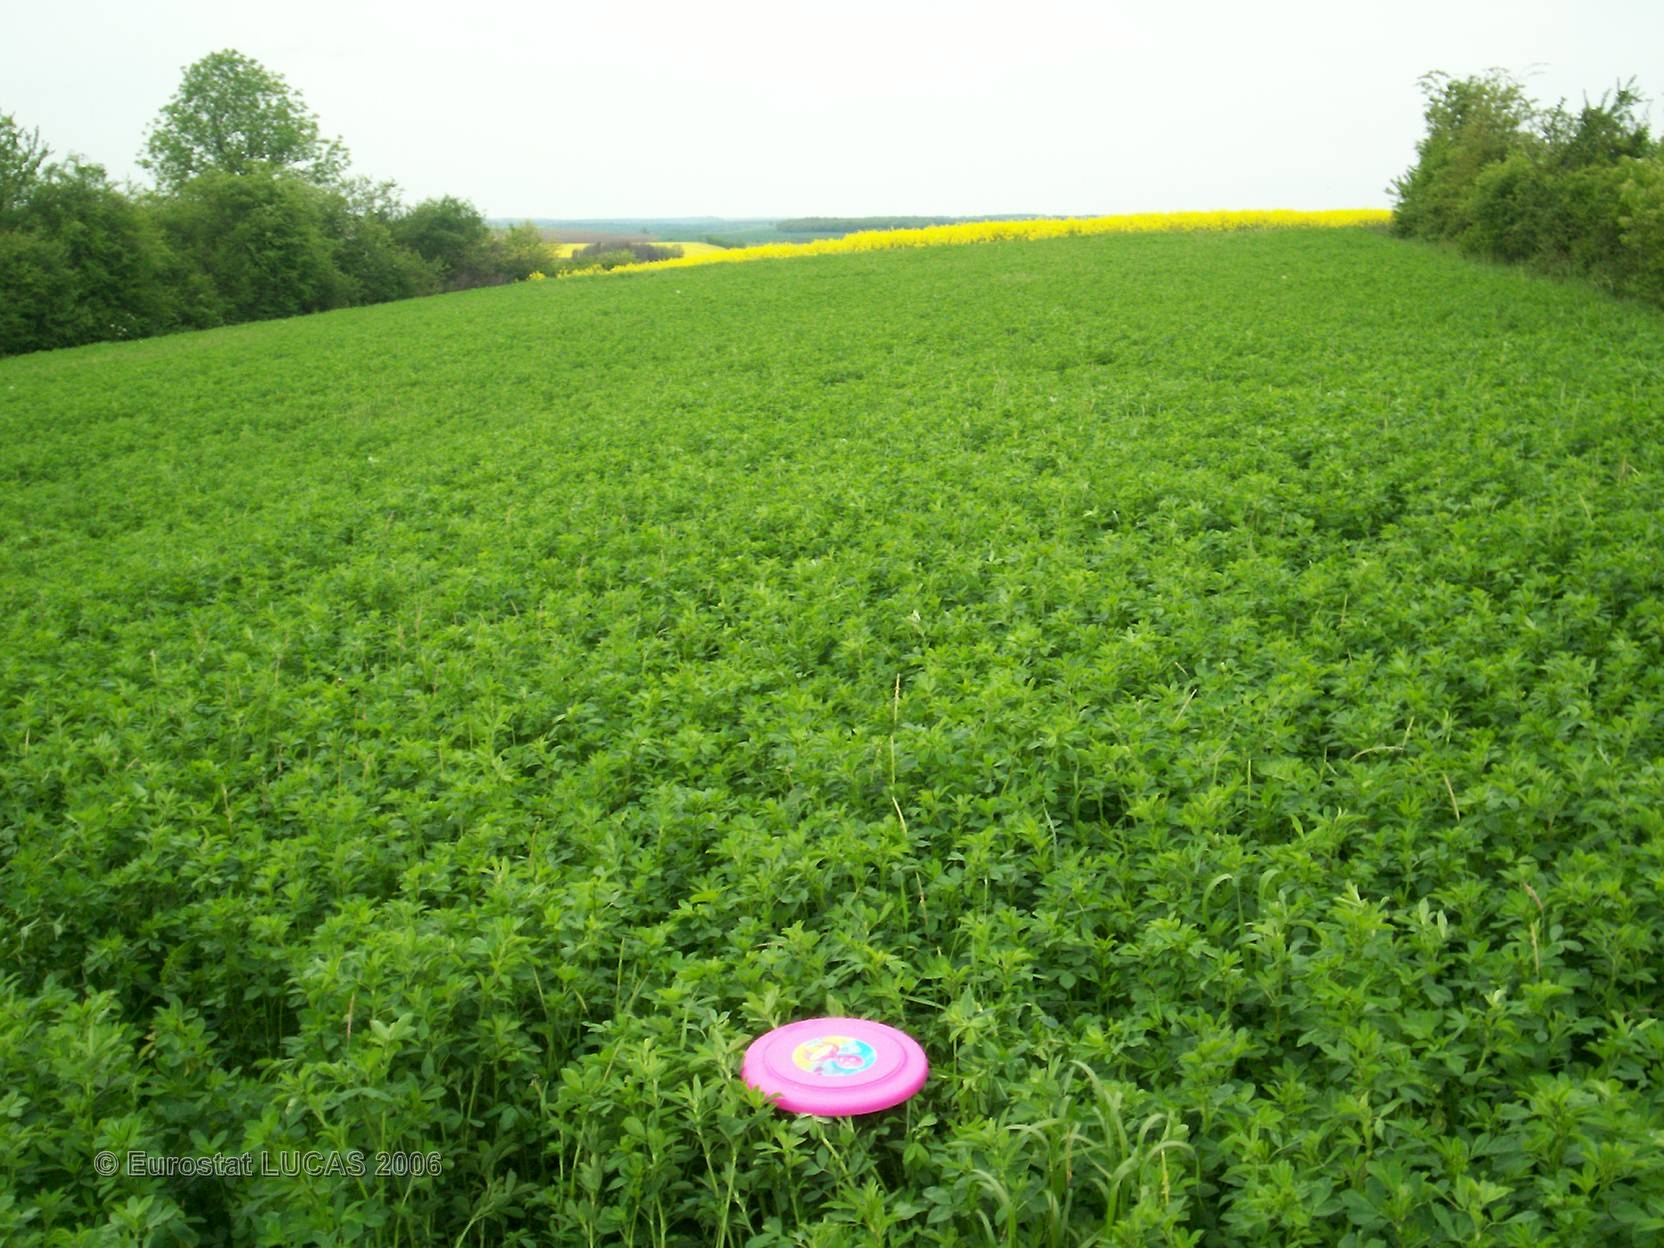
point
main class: Cropland
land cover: Lucerne
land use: Agriculture (excluding fallow land and kitchen gardens)
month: May
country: FR
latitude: 47.3190
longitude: 4.6682
